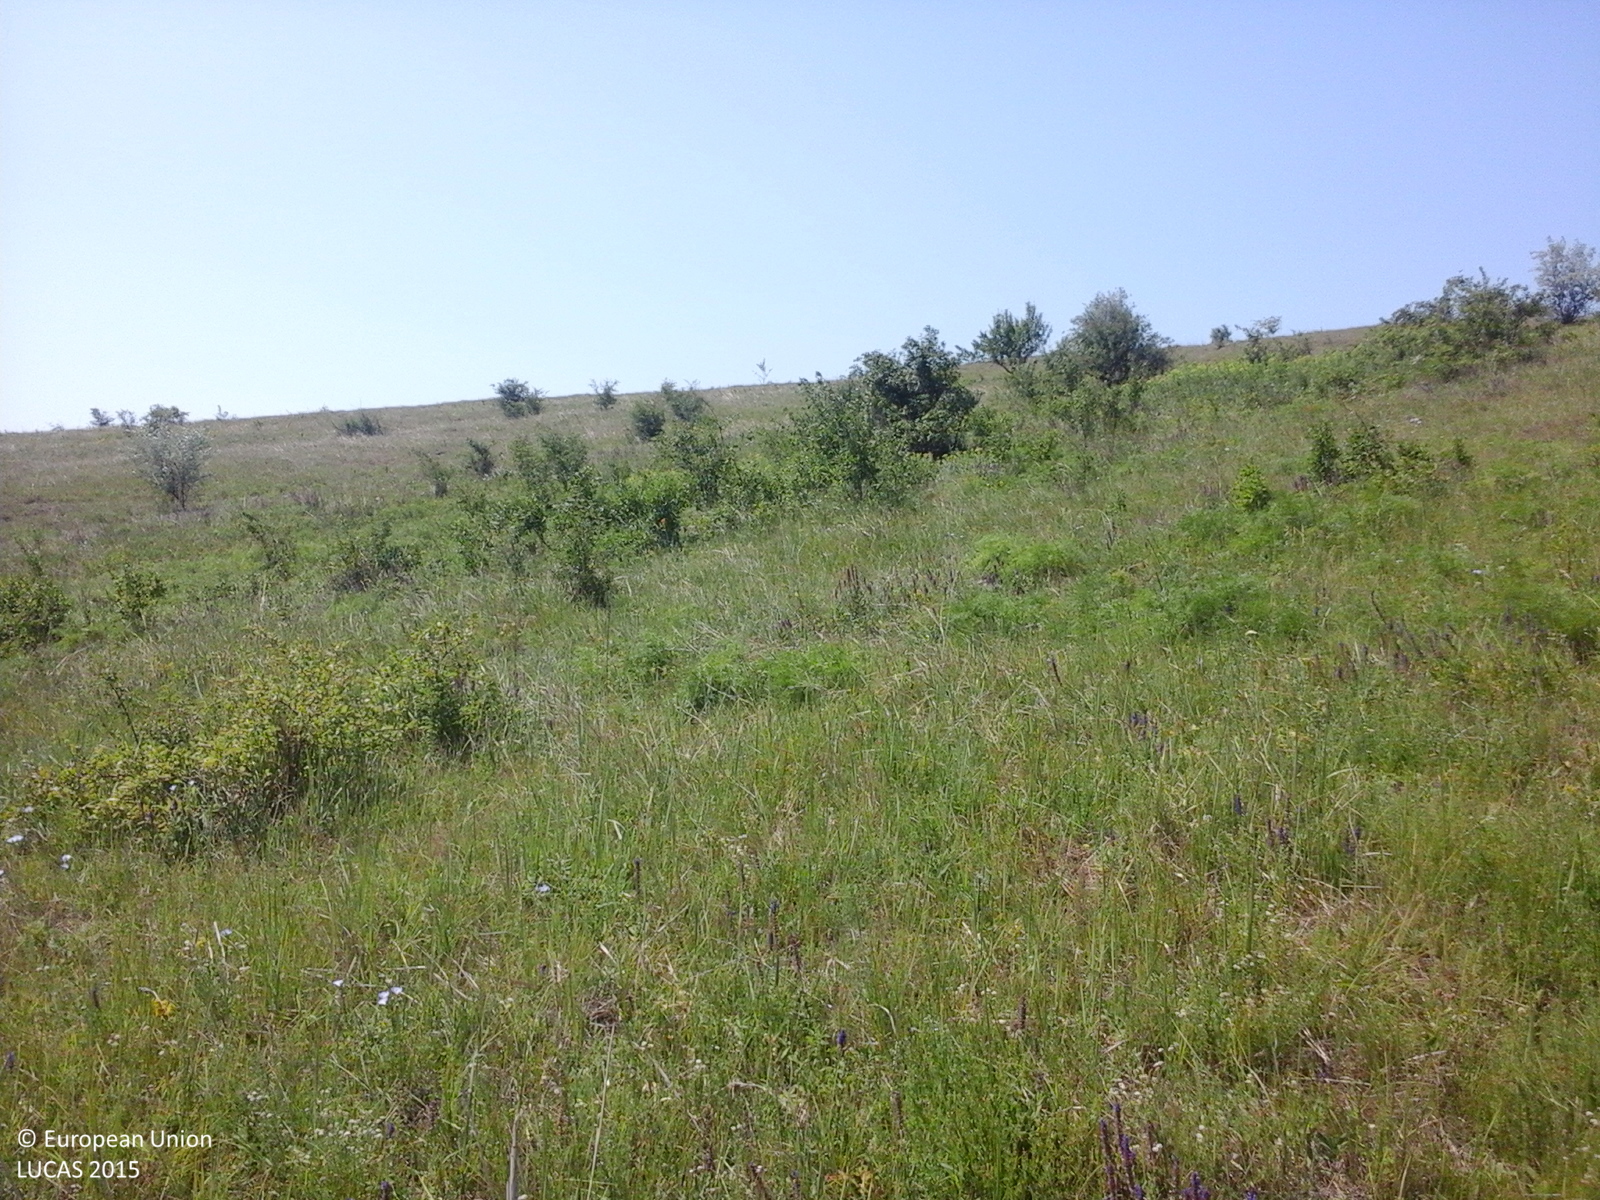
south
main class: Grassland
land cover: Grassland with sparse tree/shrub cover
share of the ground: > 75 %
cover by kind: herbaceous plants 85 %, shrubs 10 %, broadleaved forest trees 5 %
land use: Semi-natural and natural areas not in use
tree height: < 5 m
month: June
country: RO
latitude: 46.6225
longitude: 27.8443
